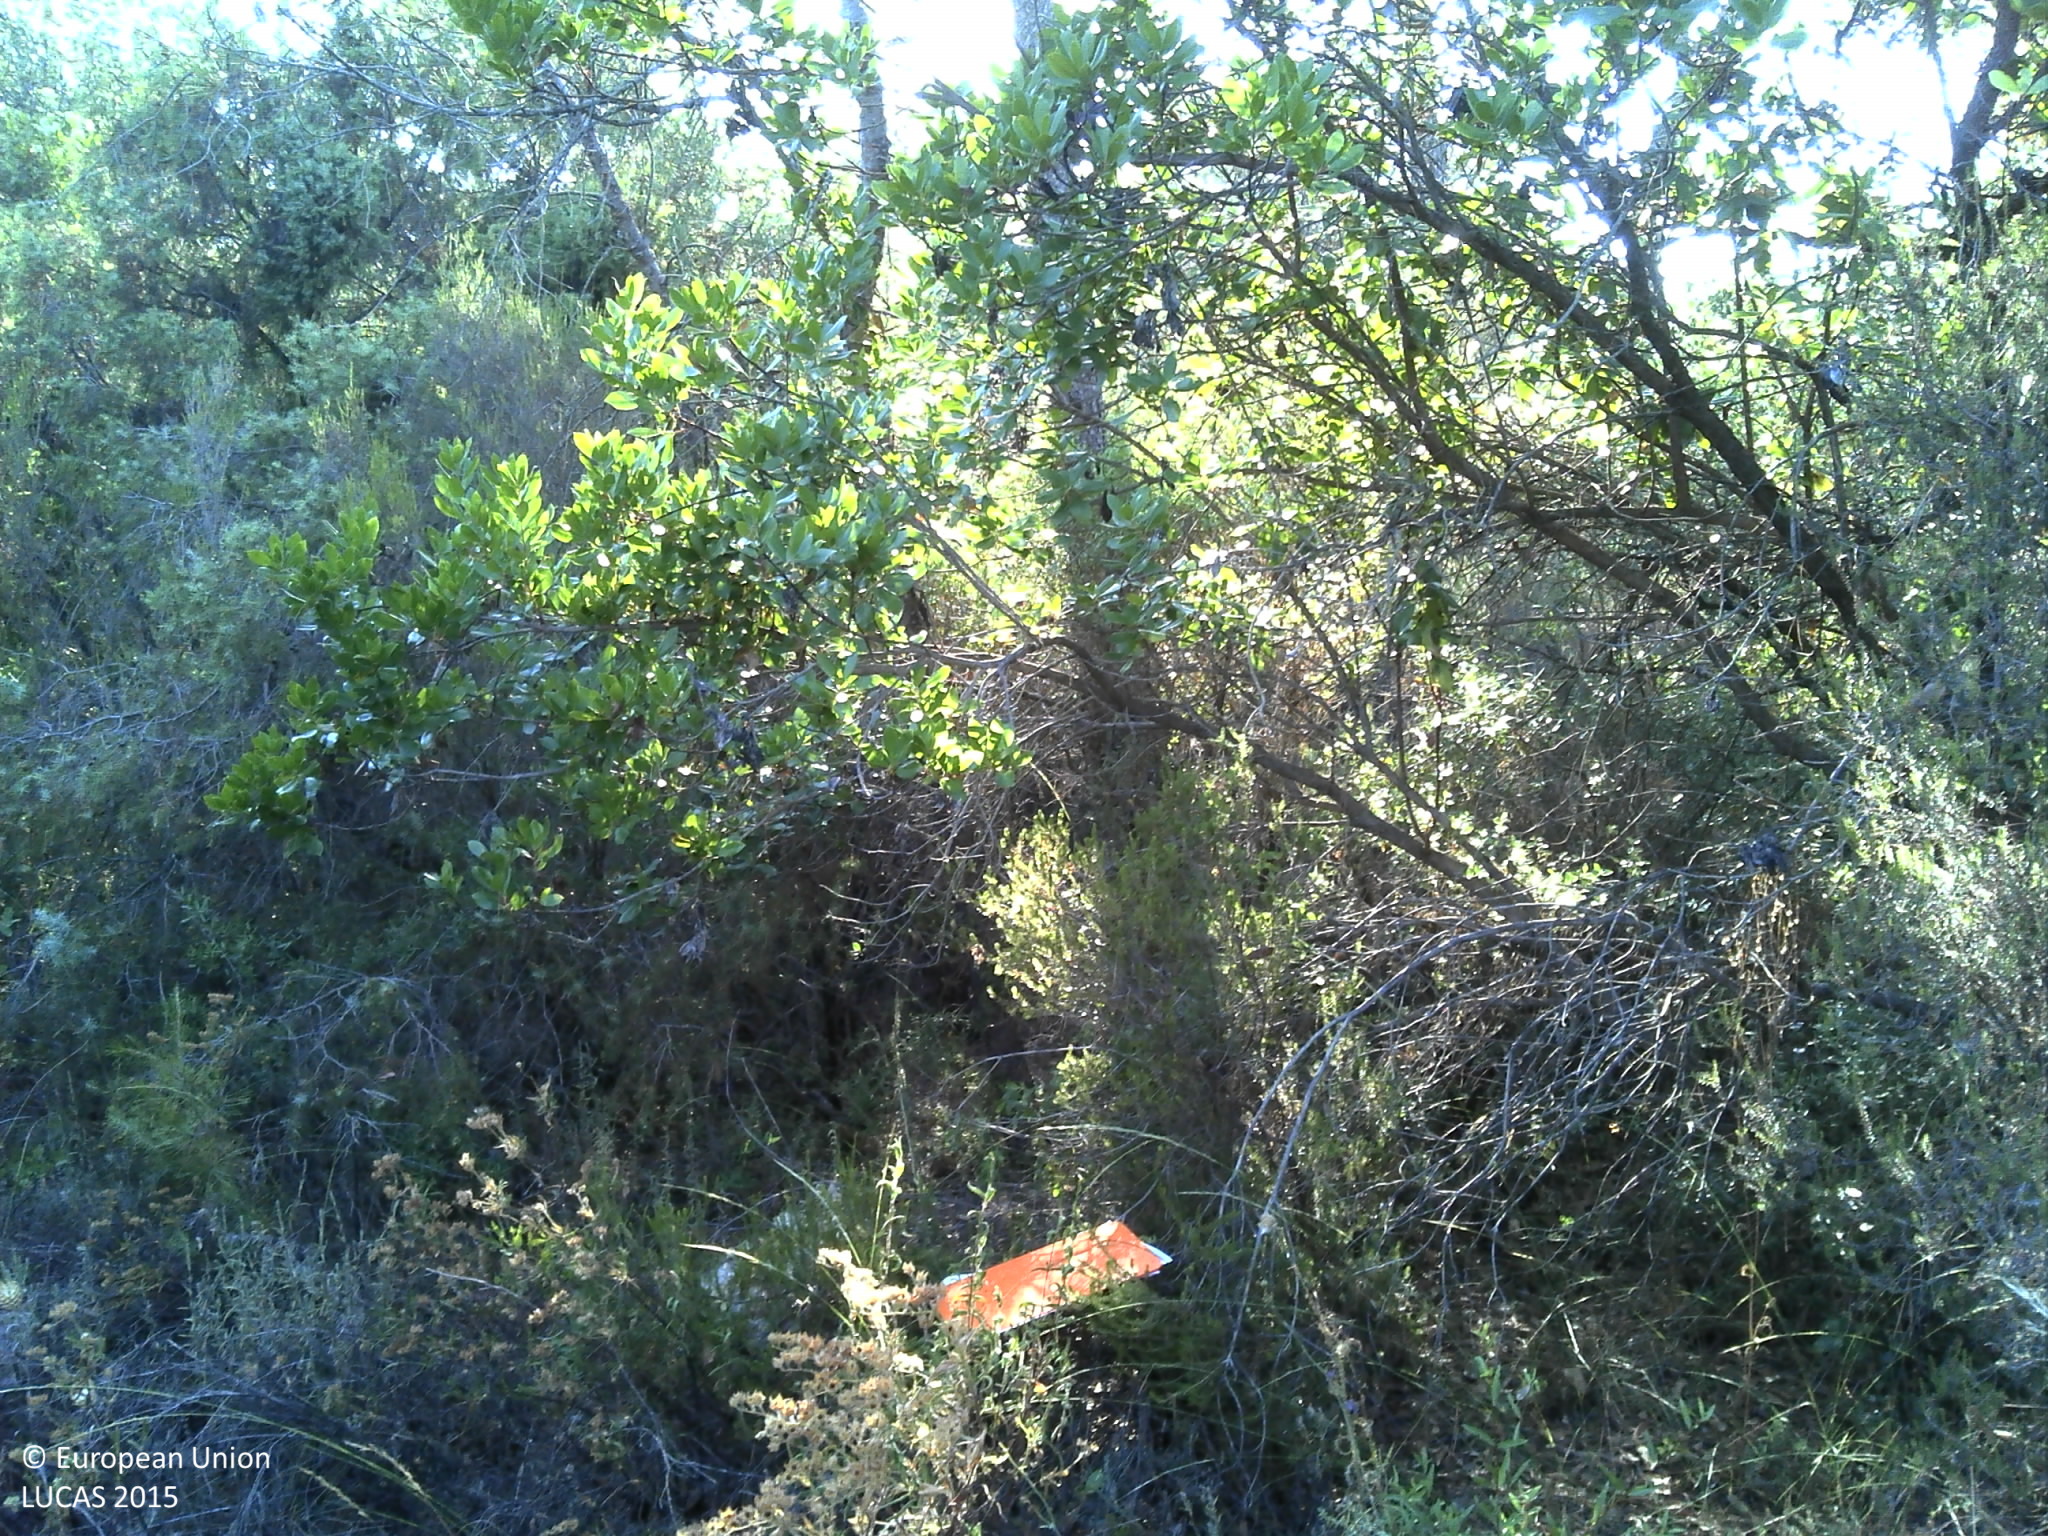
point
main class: Woodland
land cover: Other mixed woodland
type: broadleaved evergreen forest
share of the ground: > 75 %
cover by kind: broadleaved forest trees 35 %, herbaceous plants 30 %, coniferous forest trees 25 %, unconsolidated bare surface 10 %
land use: Forestry
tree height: < 5 m
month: July
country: FR
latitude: 43.6838
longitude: 3.6199
